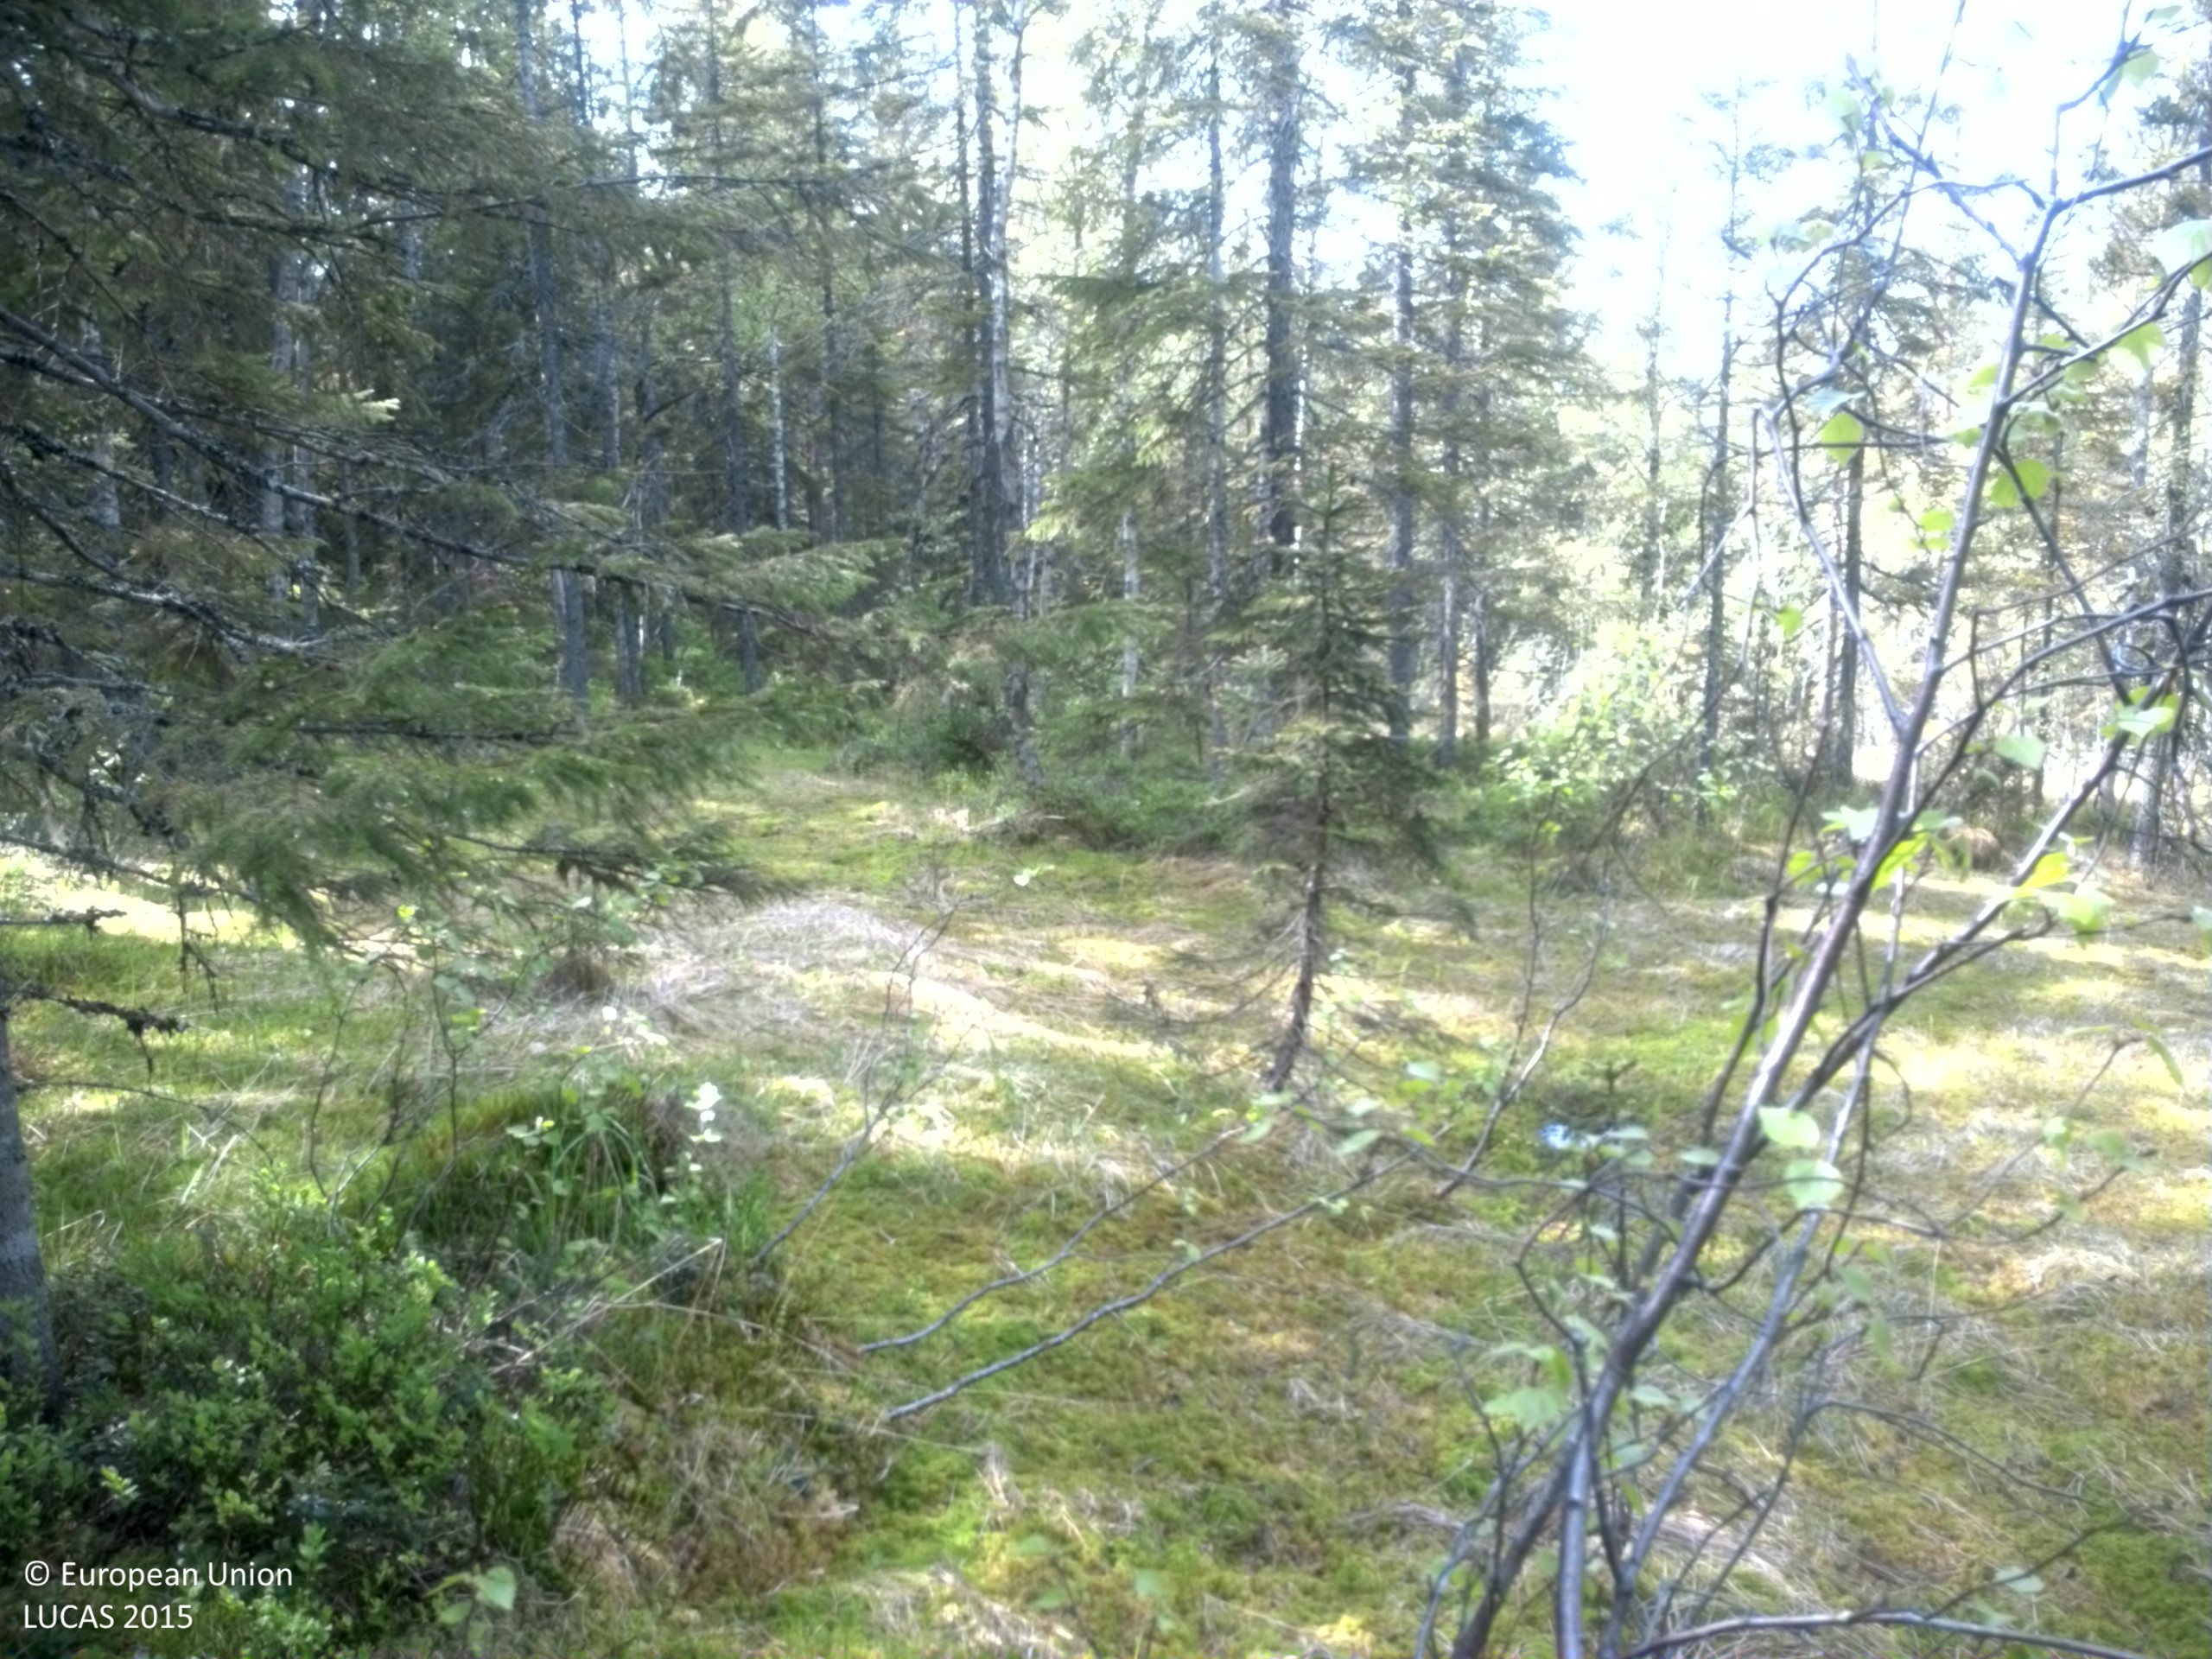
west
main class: Woodland
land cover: Spruce dominated mixed woodland
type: boreal forest
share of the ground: 50 - 75 %
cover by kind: coniferous forest trees 45 %, lichens and mosses 30 %, broadleaved forest trees 15 %, shrubs 10 %
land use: Forestry
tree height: > 5 m
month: June
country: SE
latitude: 62.9080
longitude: 17.9892
